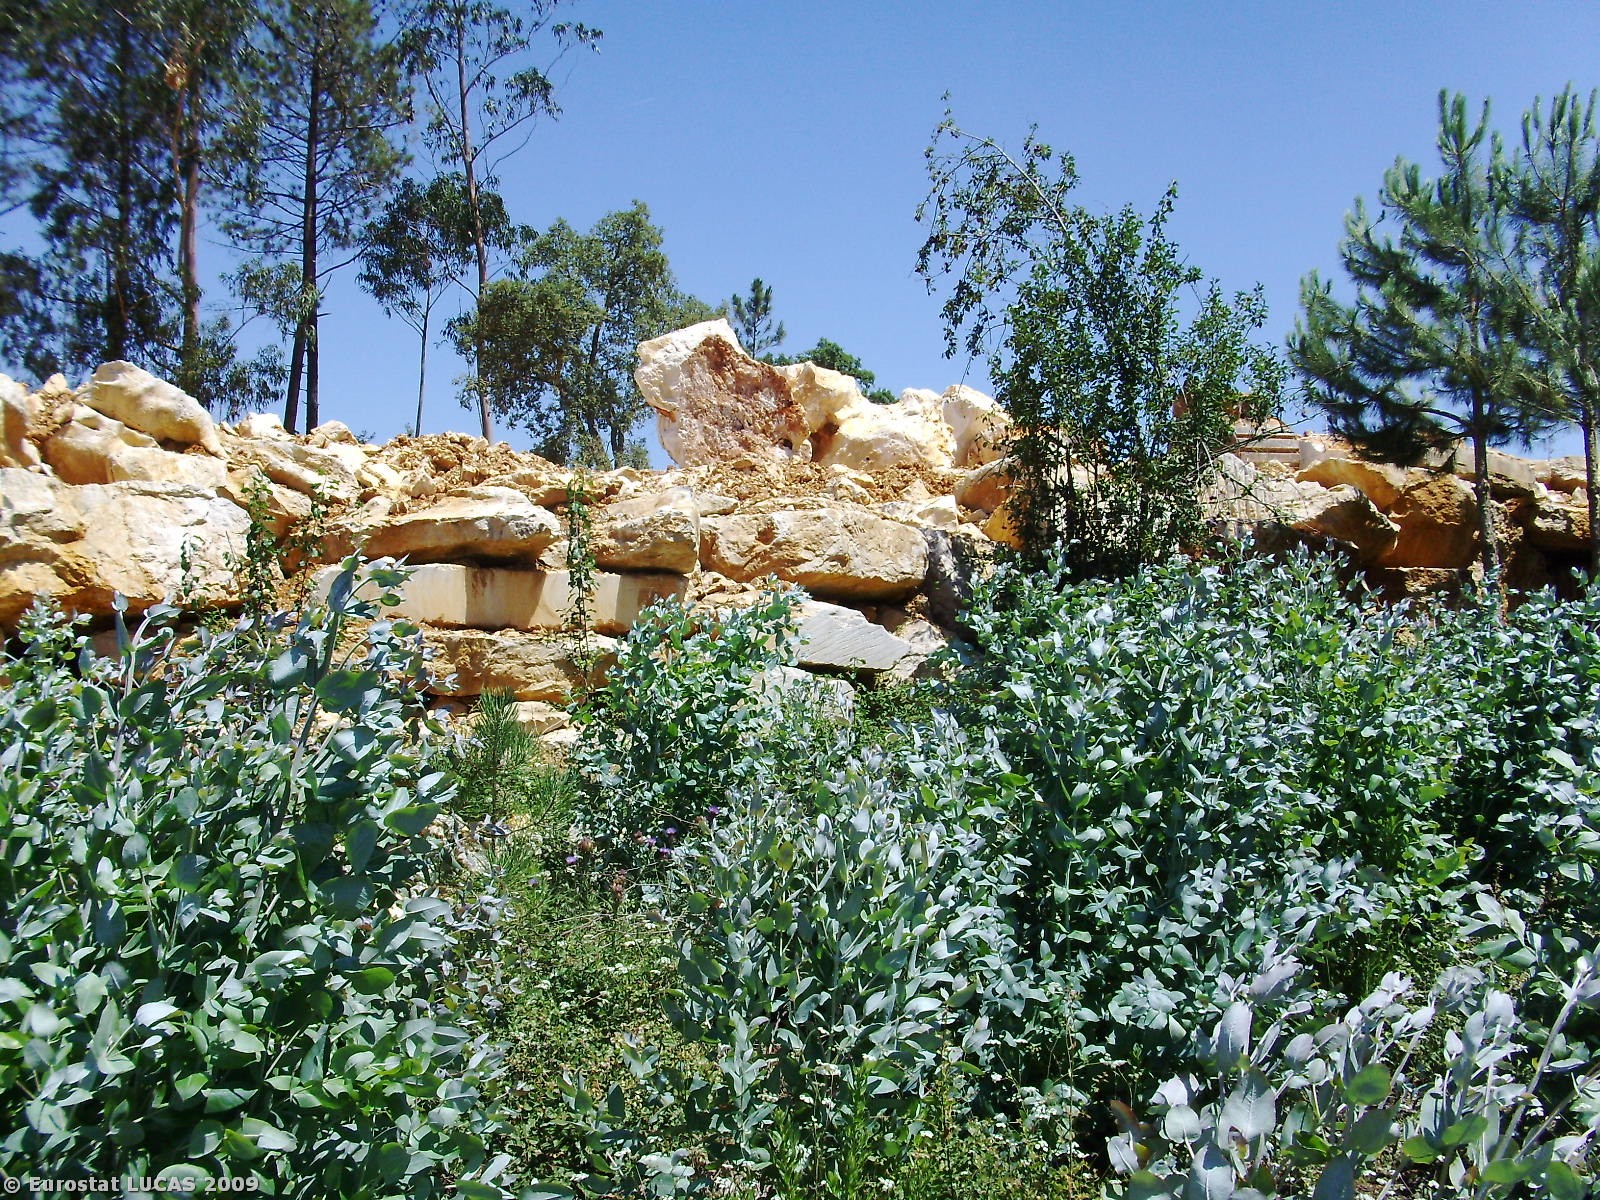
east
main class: Woodland
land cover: Broadleaved woodland
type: plantations and self-sown exotic forest
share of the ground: 50 - 75 %
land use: Forestry
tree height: > 5 m
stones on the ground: > 50 %
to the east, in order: Broadleaved woodland; Spontaneously vegetated surfaces; Broadleaved woodland; Bare land; Broadleaved woodland; Bare land
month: July
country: PT
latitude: 39.5586
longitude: -8.9049
